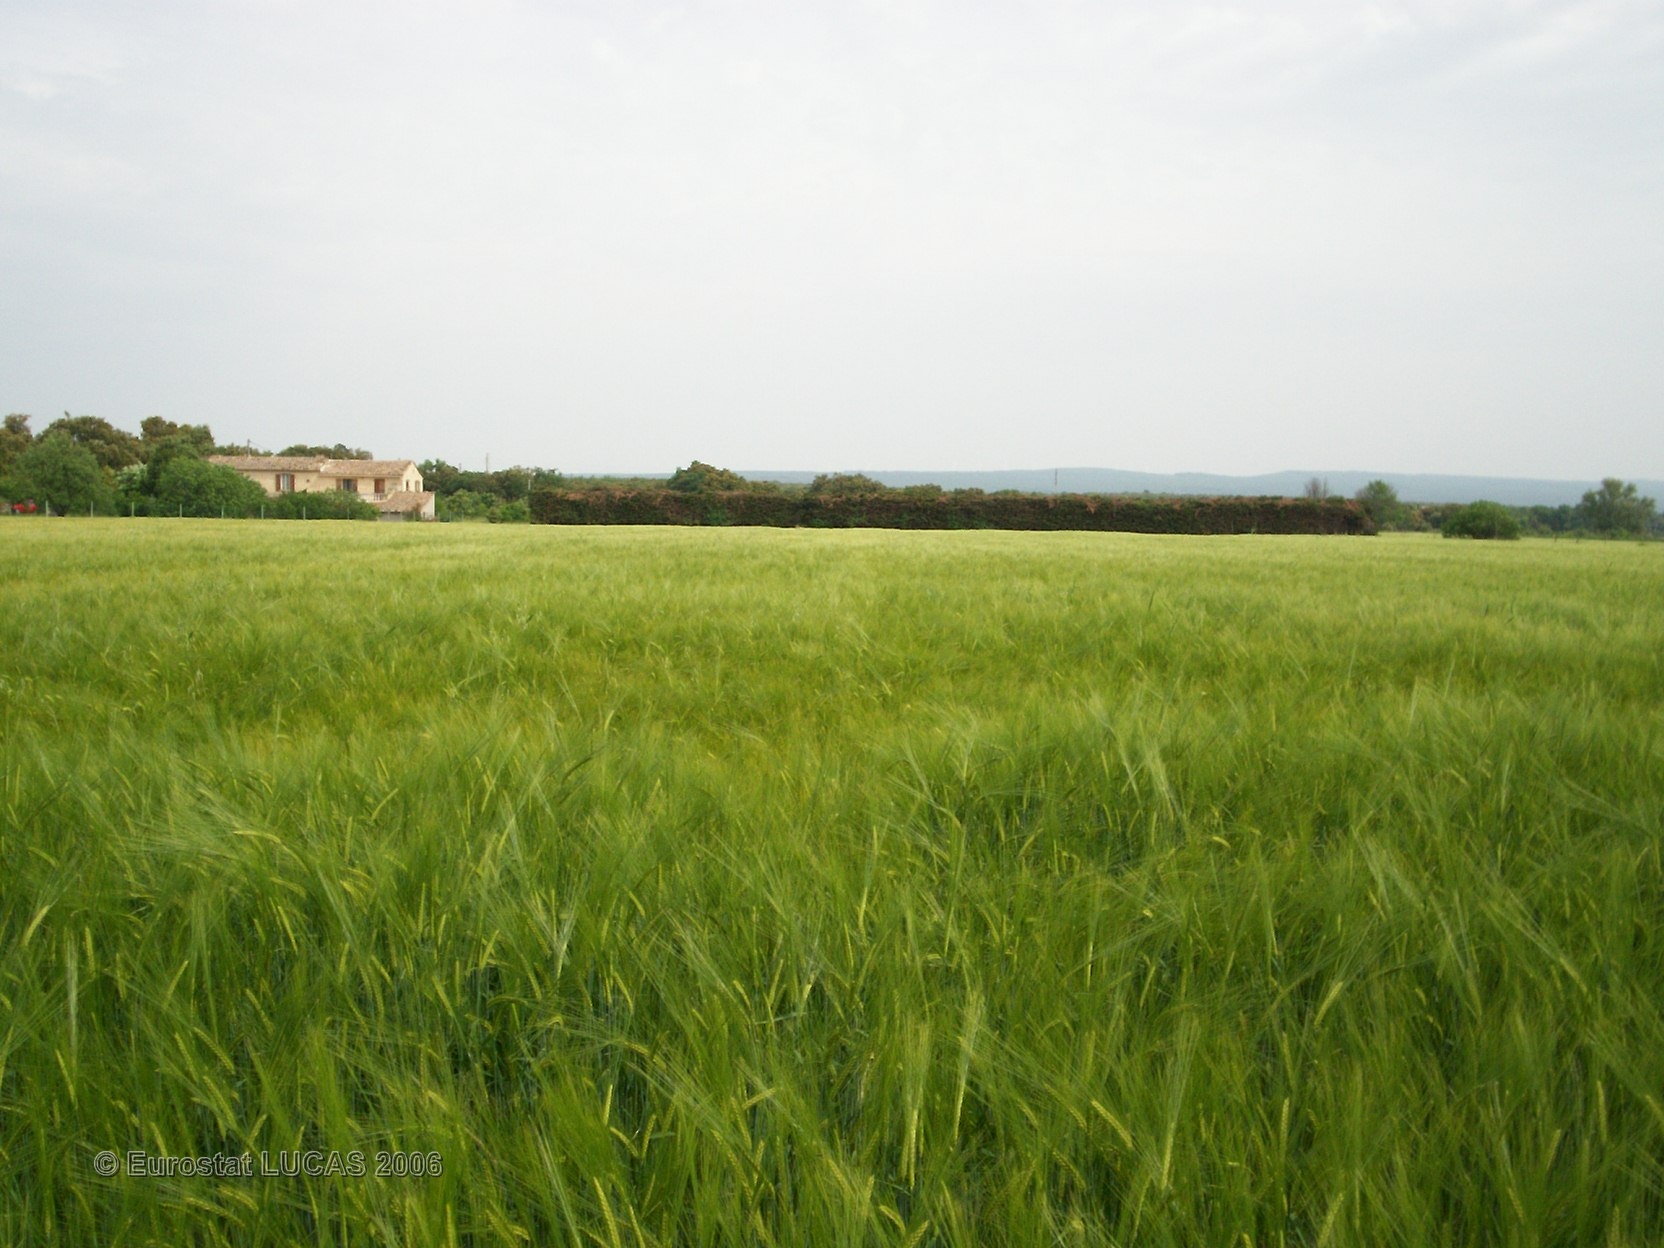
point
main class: Cropland
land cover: Barley
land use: Agriculture (excluding fallow land and kitchen gardens)
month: May
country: FR
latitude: 44.4045
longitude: 4.8716
